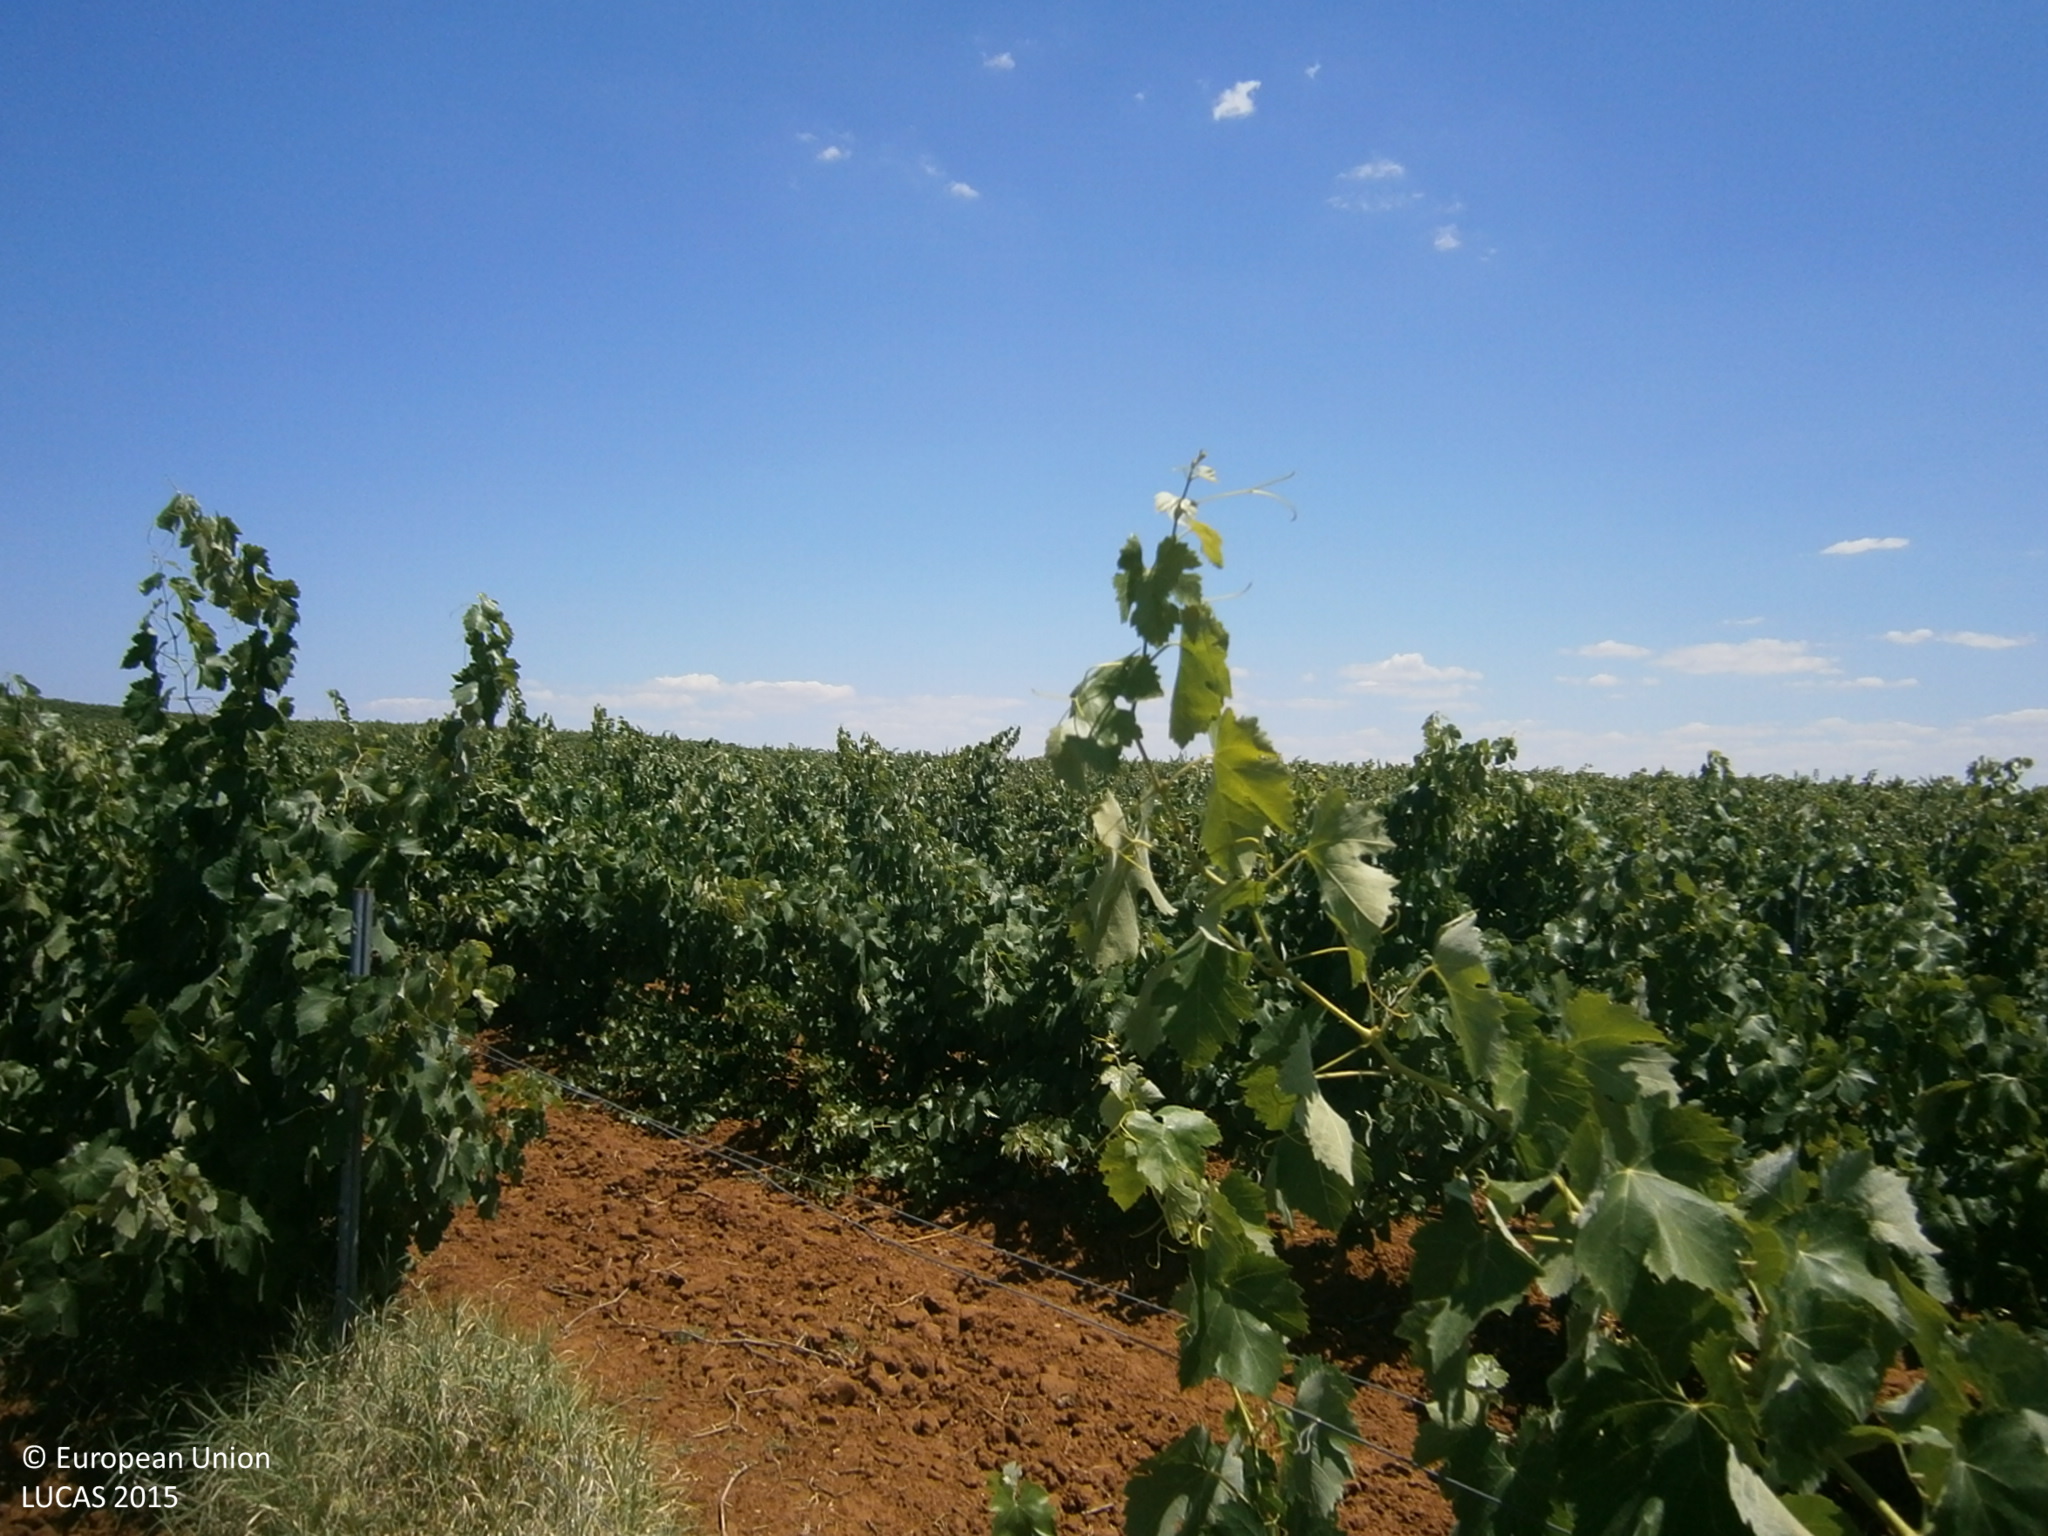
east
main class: Cropland
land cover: Vineyards
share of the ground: 50 - 75 %
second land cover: Spontaneously vegetated surfaces
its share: 10 - 25 %
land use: Agriculture (excluding fallow land and kitchen gardens)
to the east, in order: Vineyards; Spontaneously vegetated surfaces; Other bare soil; Tracks; Vineyards; Other bare soil
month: June
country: ES
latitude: 38.7783
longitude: -6.6484
